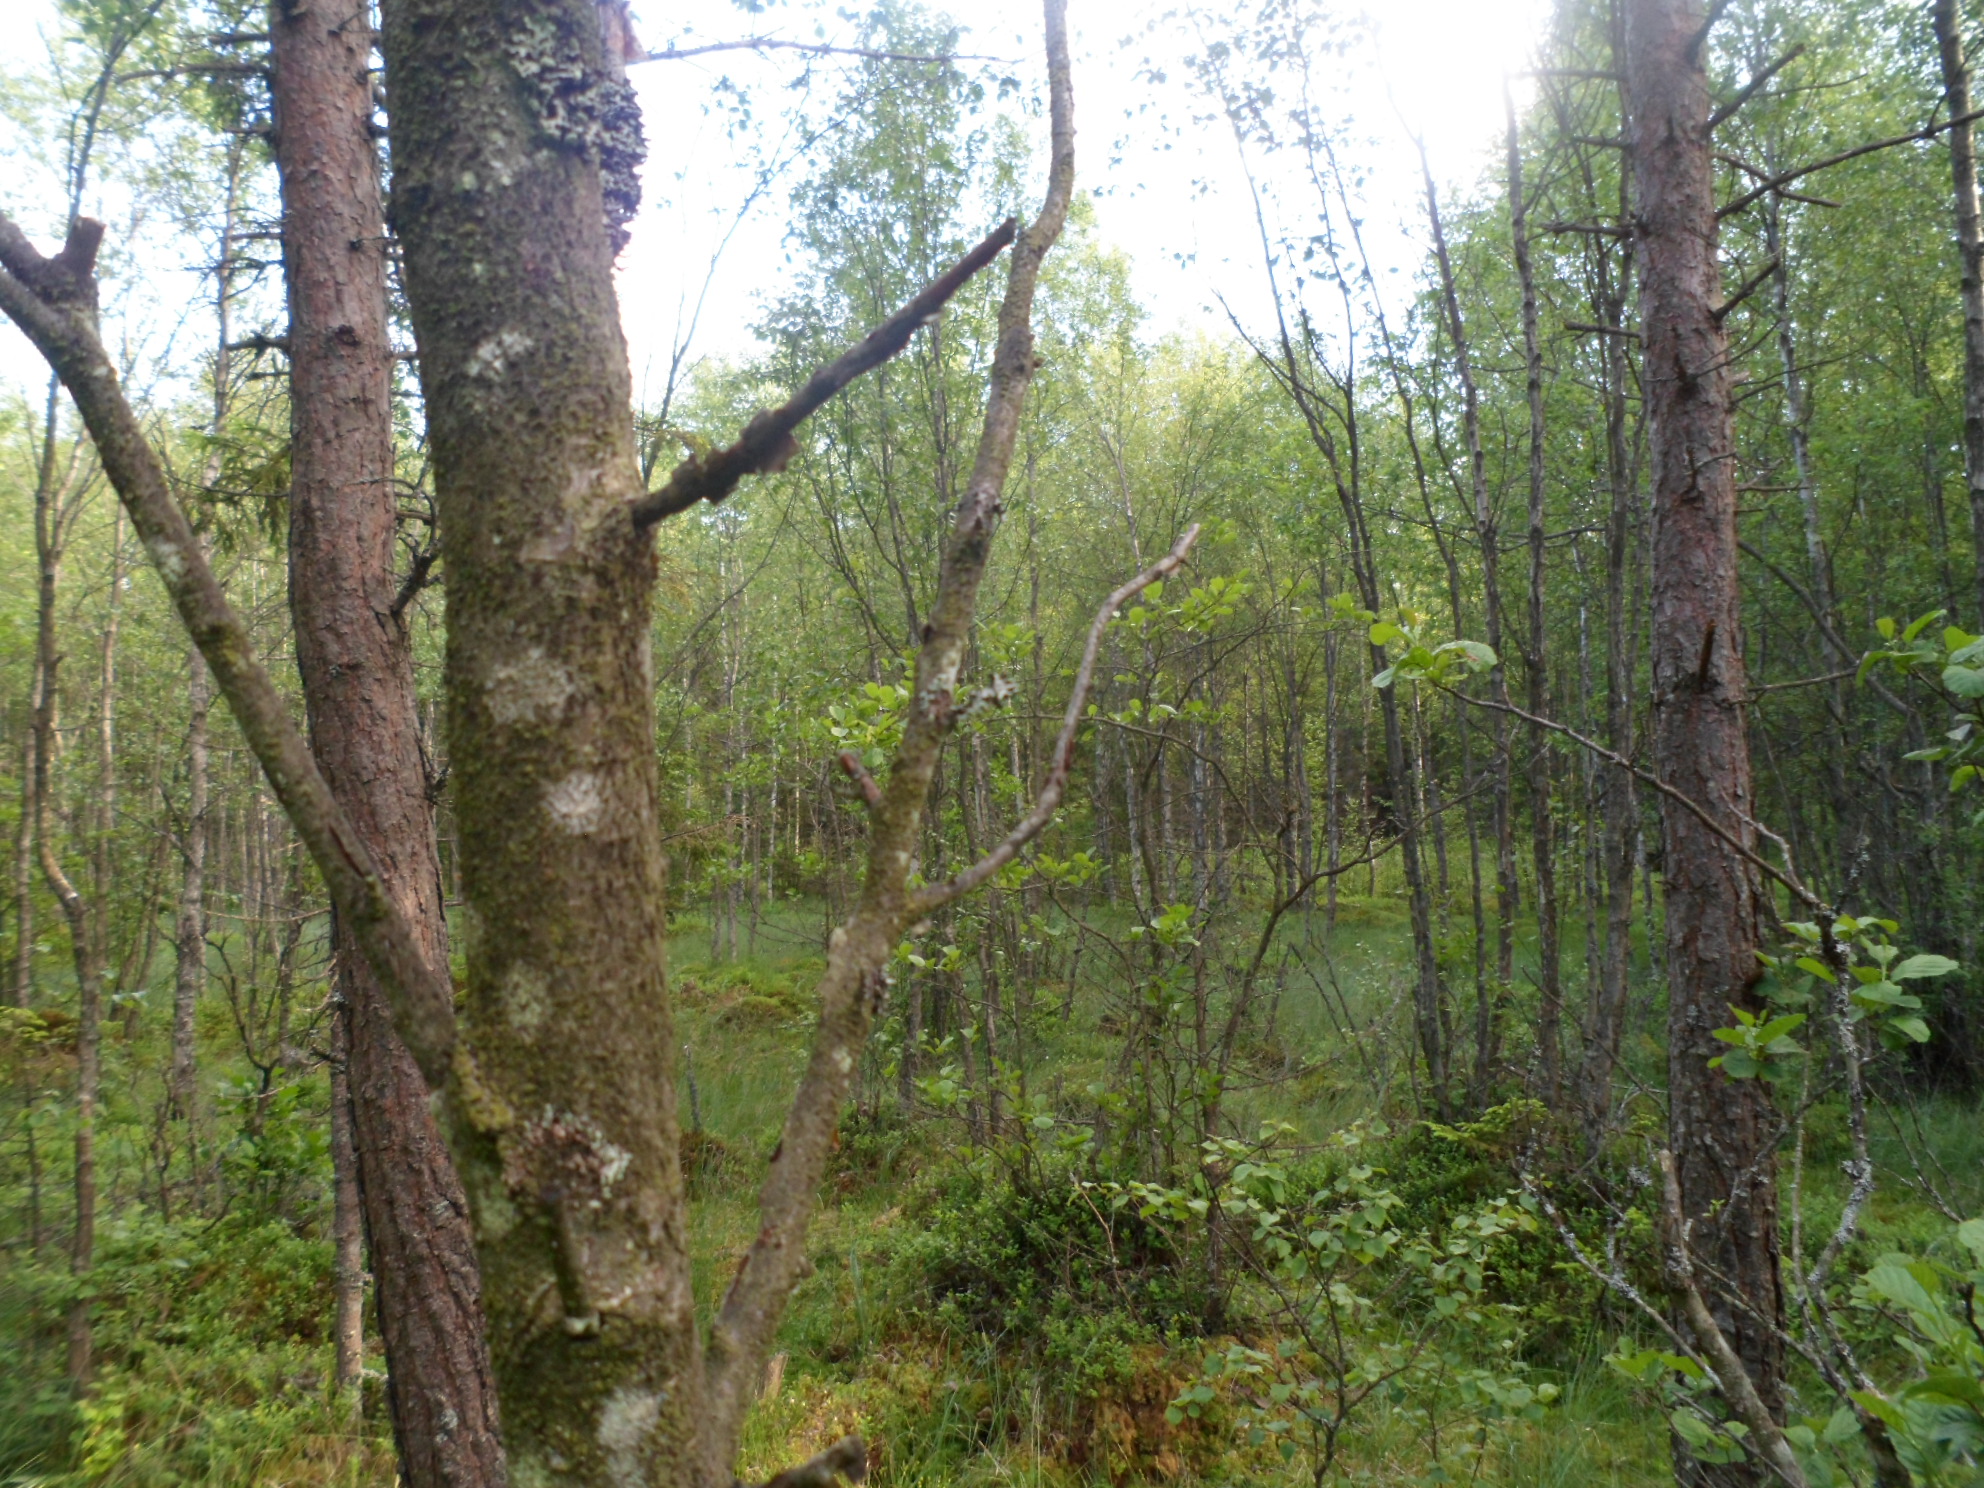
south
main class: Woodland
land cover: Pine dominated mixed woodland
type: boreal forest
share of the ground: 25 - 50 %
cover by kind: lichens and mosses 30 %, coniferous forest trees 25 %, broadleaved forest trees 25 %, shrubs 10 %, herbaceous plants 10 %
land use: Forestry
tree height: > 5 m
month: June
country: SE
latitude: 57.1494
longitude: 15.1044
